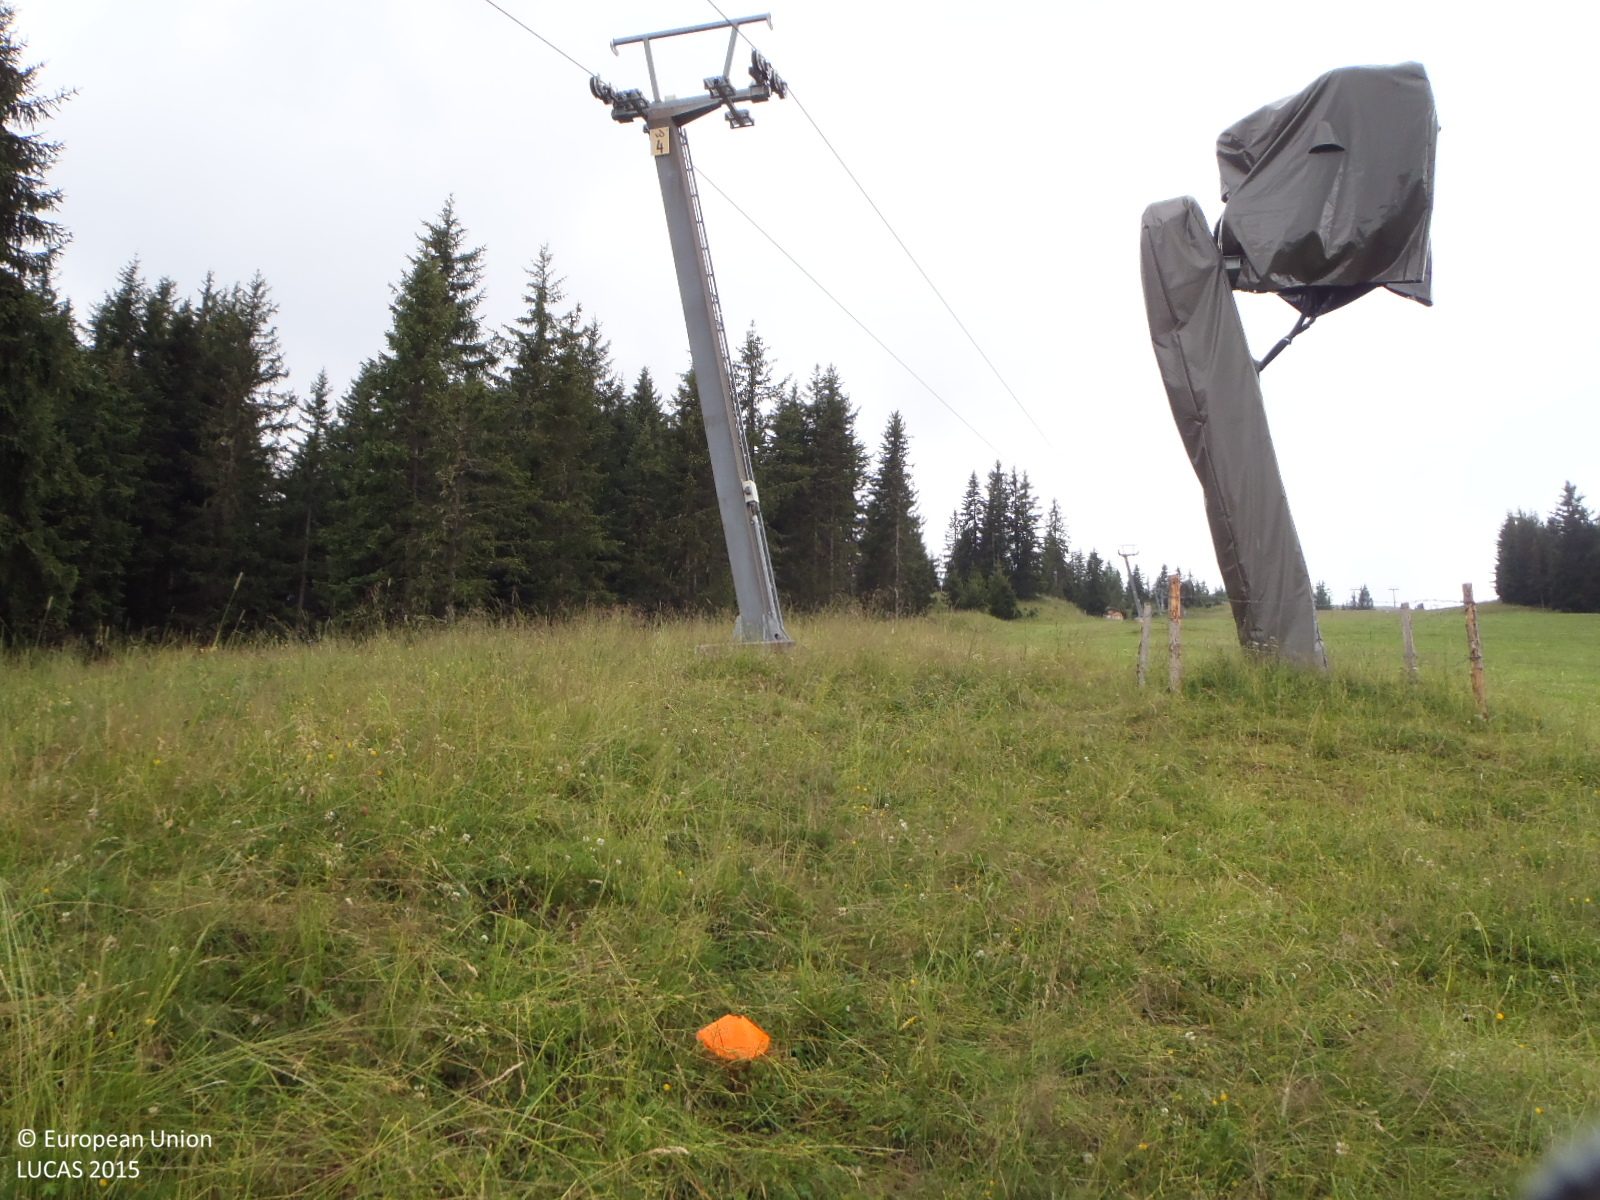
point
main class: Grassland
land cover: Grassland without tree/shrub cover
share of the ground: > 75 %
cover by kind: herbaceous plants 100 %
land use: Agriculture (excluding fallow land and kitchen gardens)
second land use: Sport
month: July
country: AT
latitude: 47.2303
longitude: 12.1511
